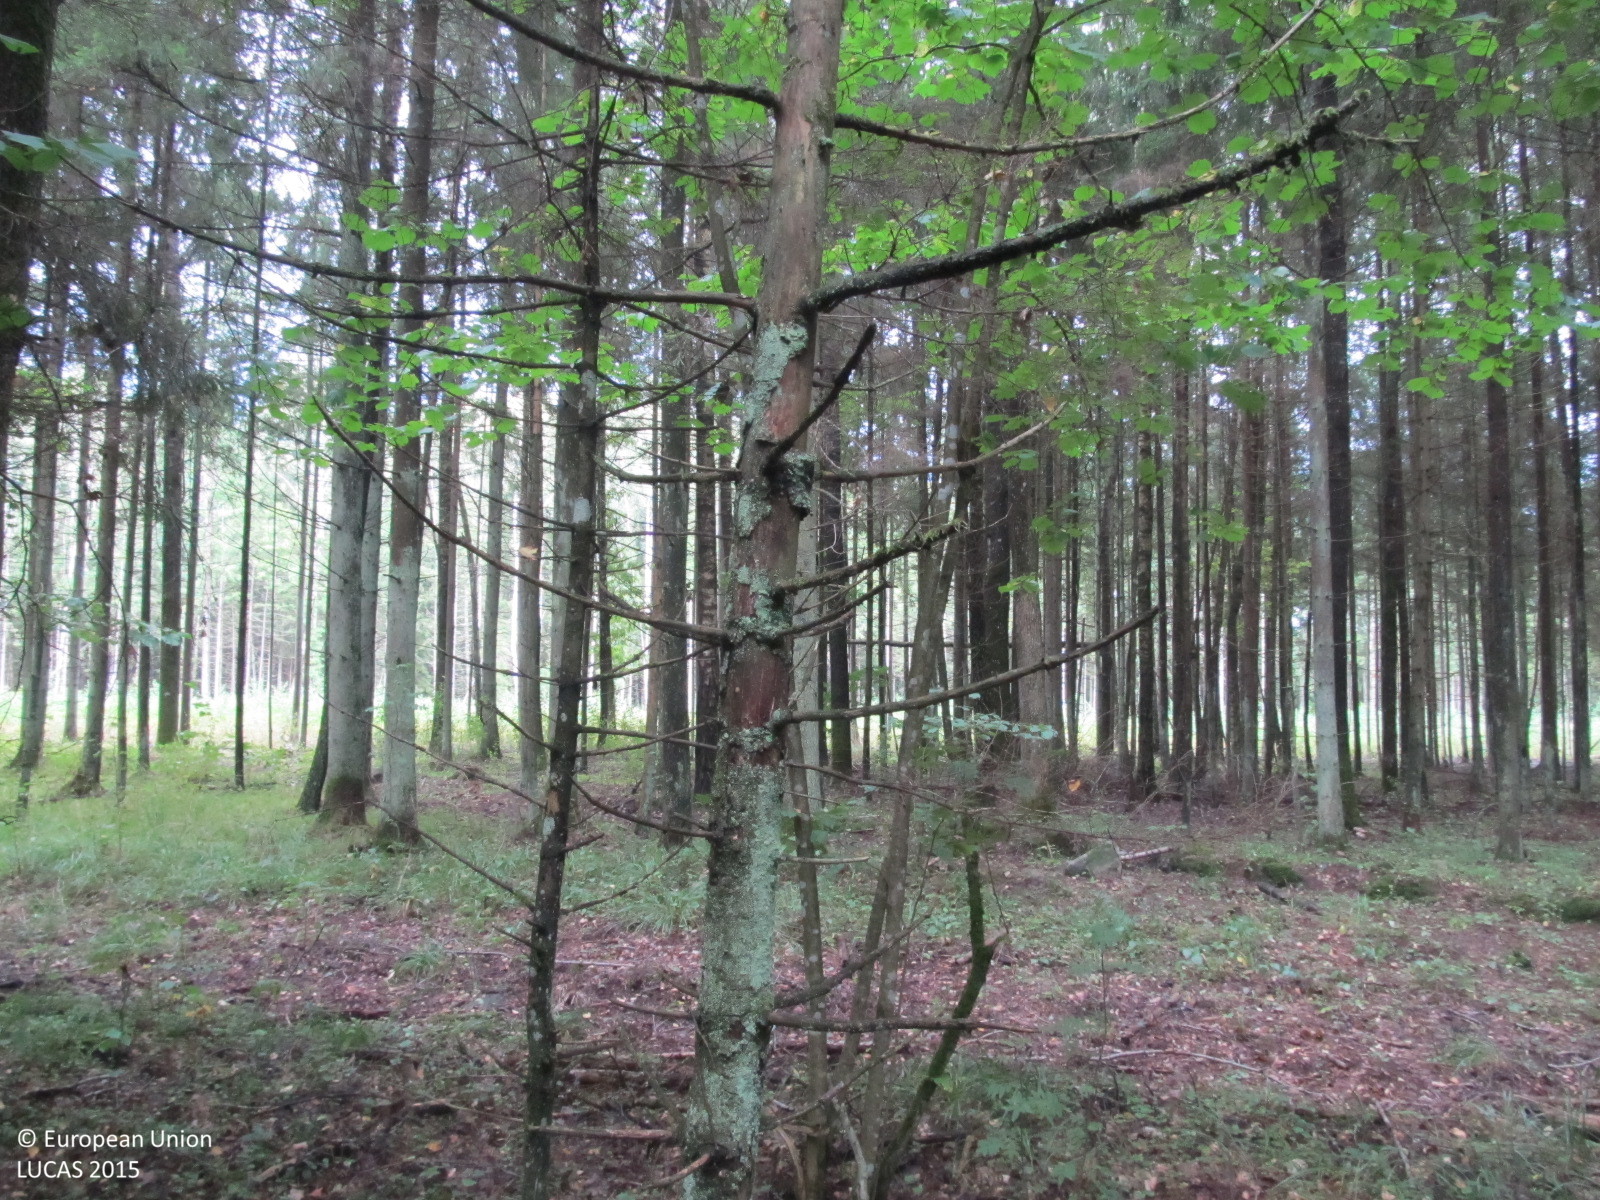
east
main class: Woodland
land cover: Spruce dominated mixed woodland
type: non-riverine alder, birch or aspen forest
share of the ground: > 75 %
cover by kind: coniferous forest trees 50 %, broadleaved forest trees 30 %, herbaceous plants 10 %, lichens and mosses 5 %, unconsolidated bare surface 5 %
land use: Forestry
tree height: > 5 m
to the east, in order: Spruce dominated mixed woodland; Tracks; Spruce dominated mixed woodland; Shrubland without tree cover; Tracks; Shrubland without tree cover; Spruce dominated mixed woodland; Tracks; Spruce dominated mixed woodland; Tracks; Spruce dominated mixed woodland; Spontaneously vegetated surfaces; Other mixed woodland
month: September
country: LT
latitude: 55.9979
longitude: 22.8115
